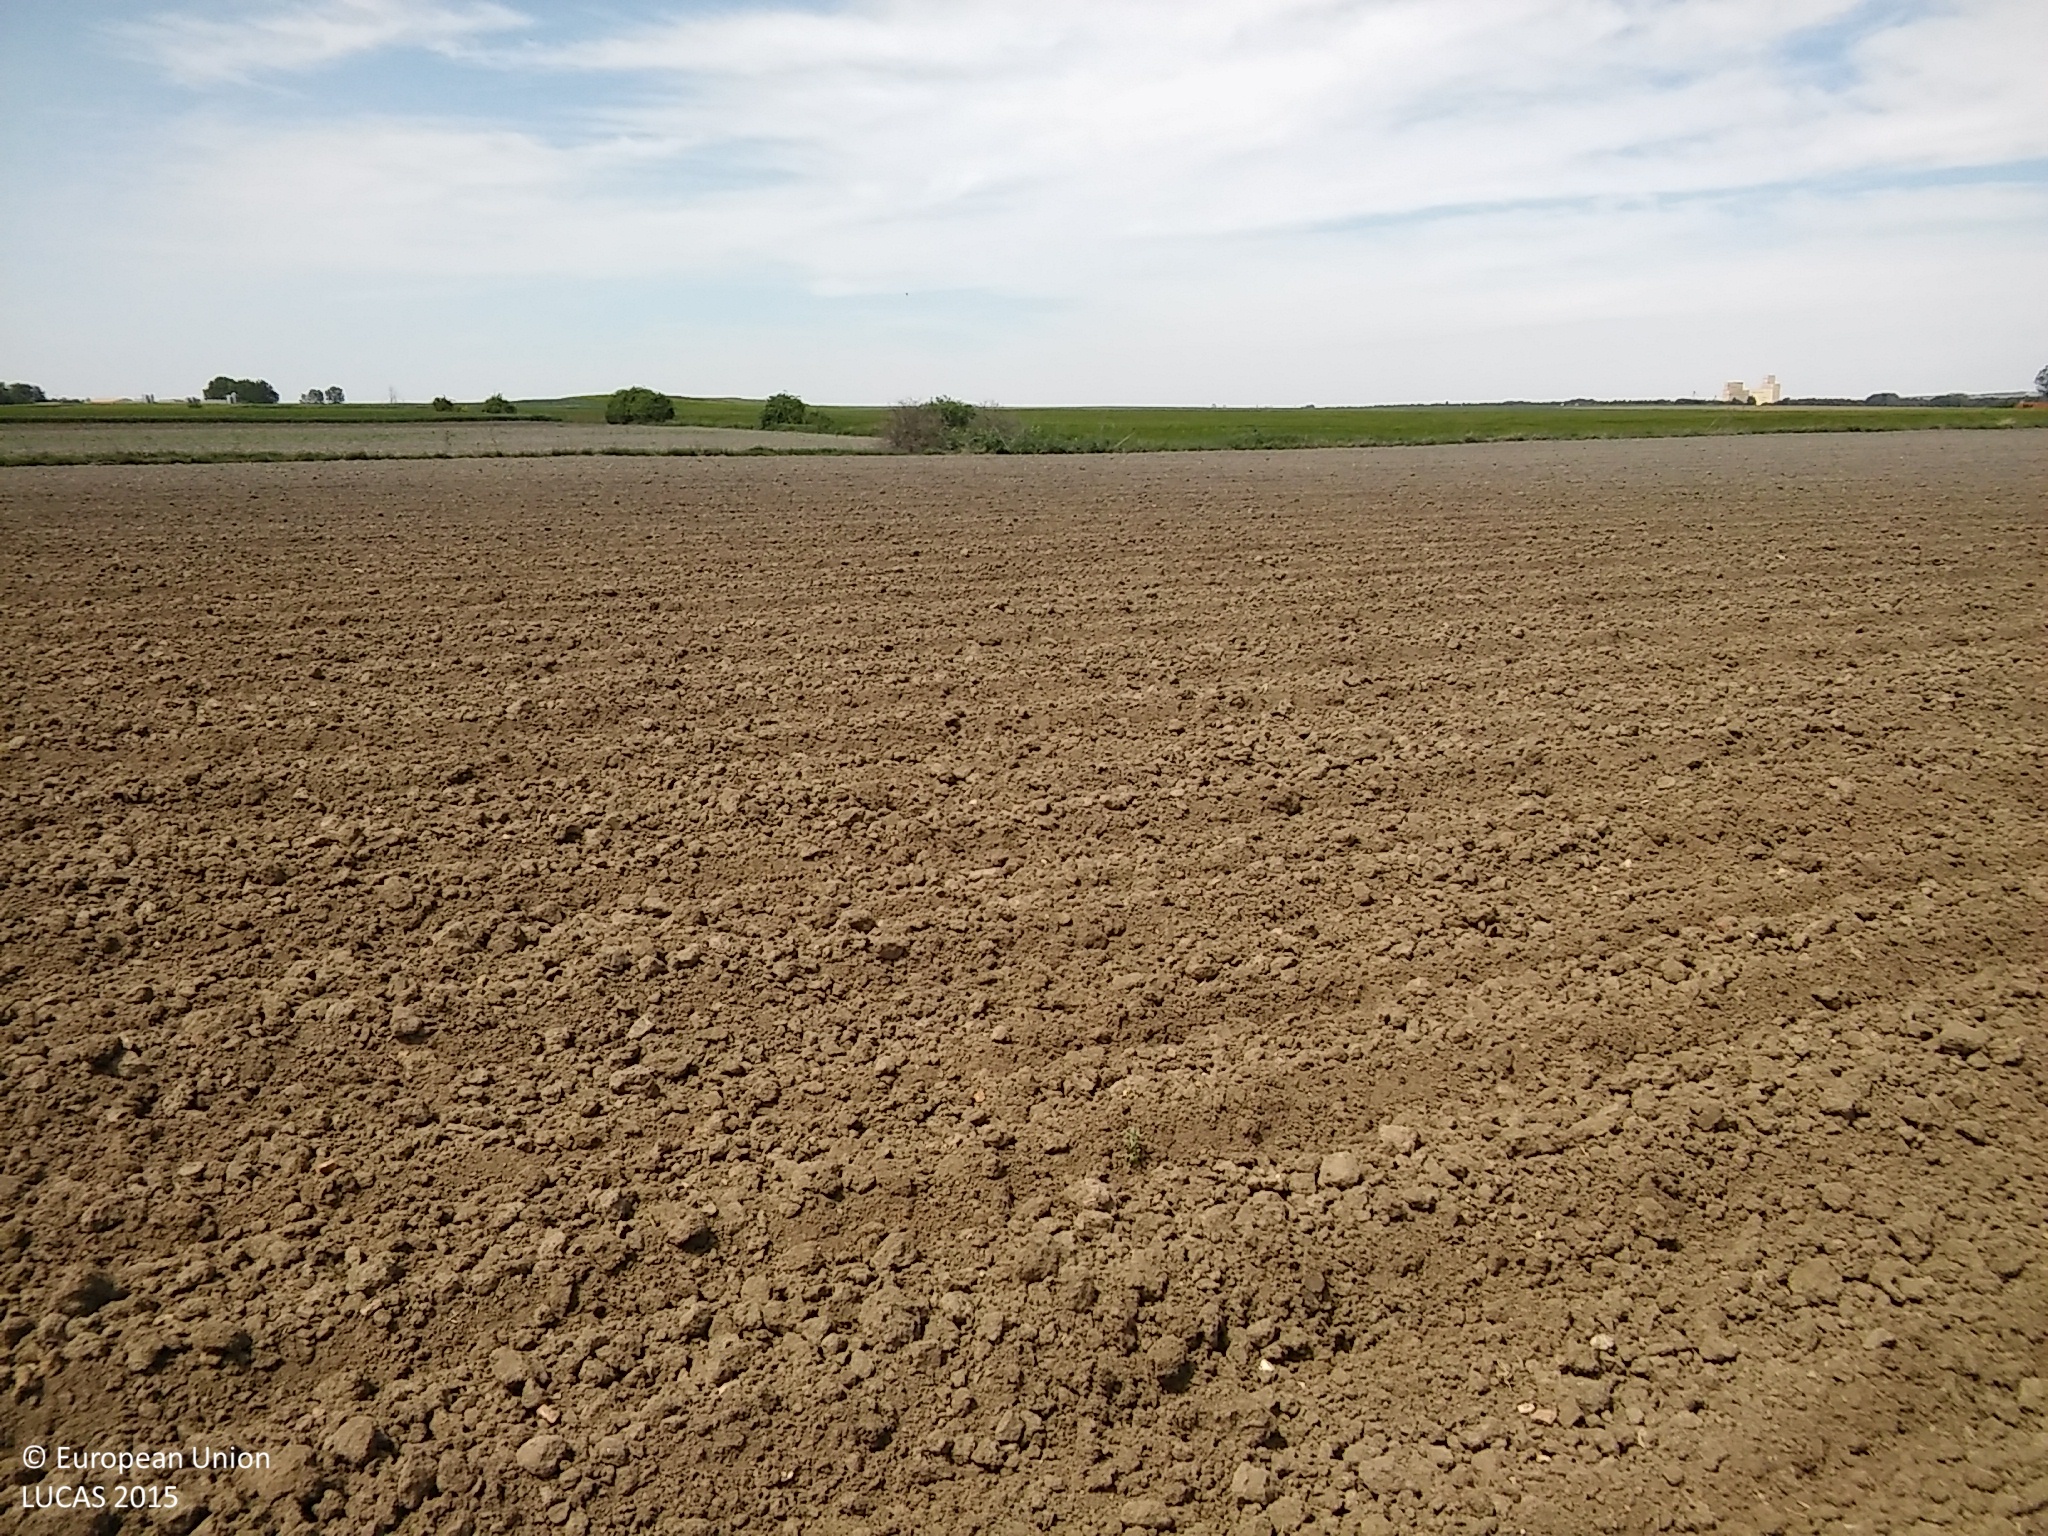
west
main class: Cropland
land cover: Sunflower
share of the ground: < 10 %
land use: Agriculture (excluding fallow land and kitchen gardens)
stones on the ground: < 10 %
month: May
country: ES
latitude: 41.2202
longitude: -4.1171
